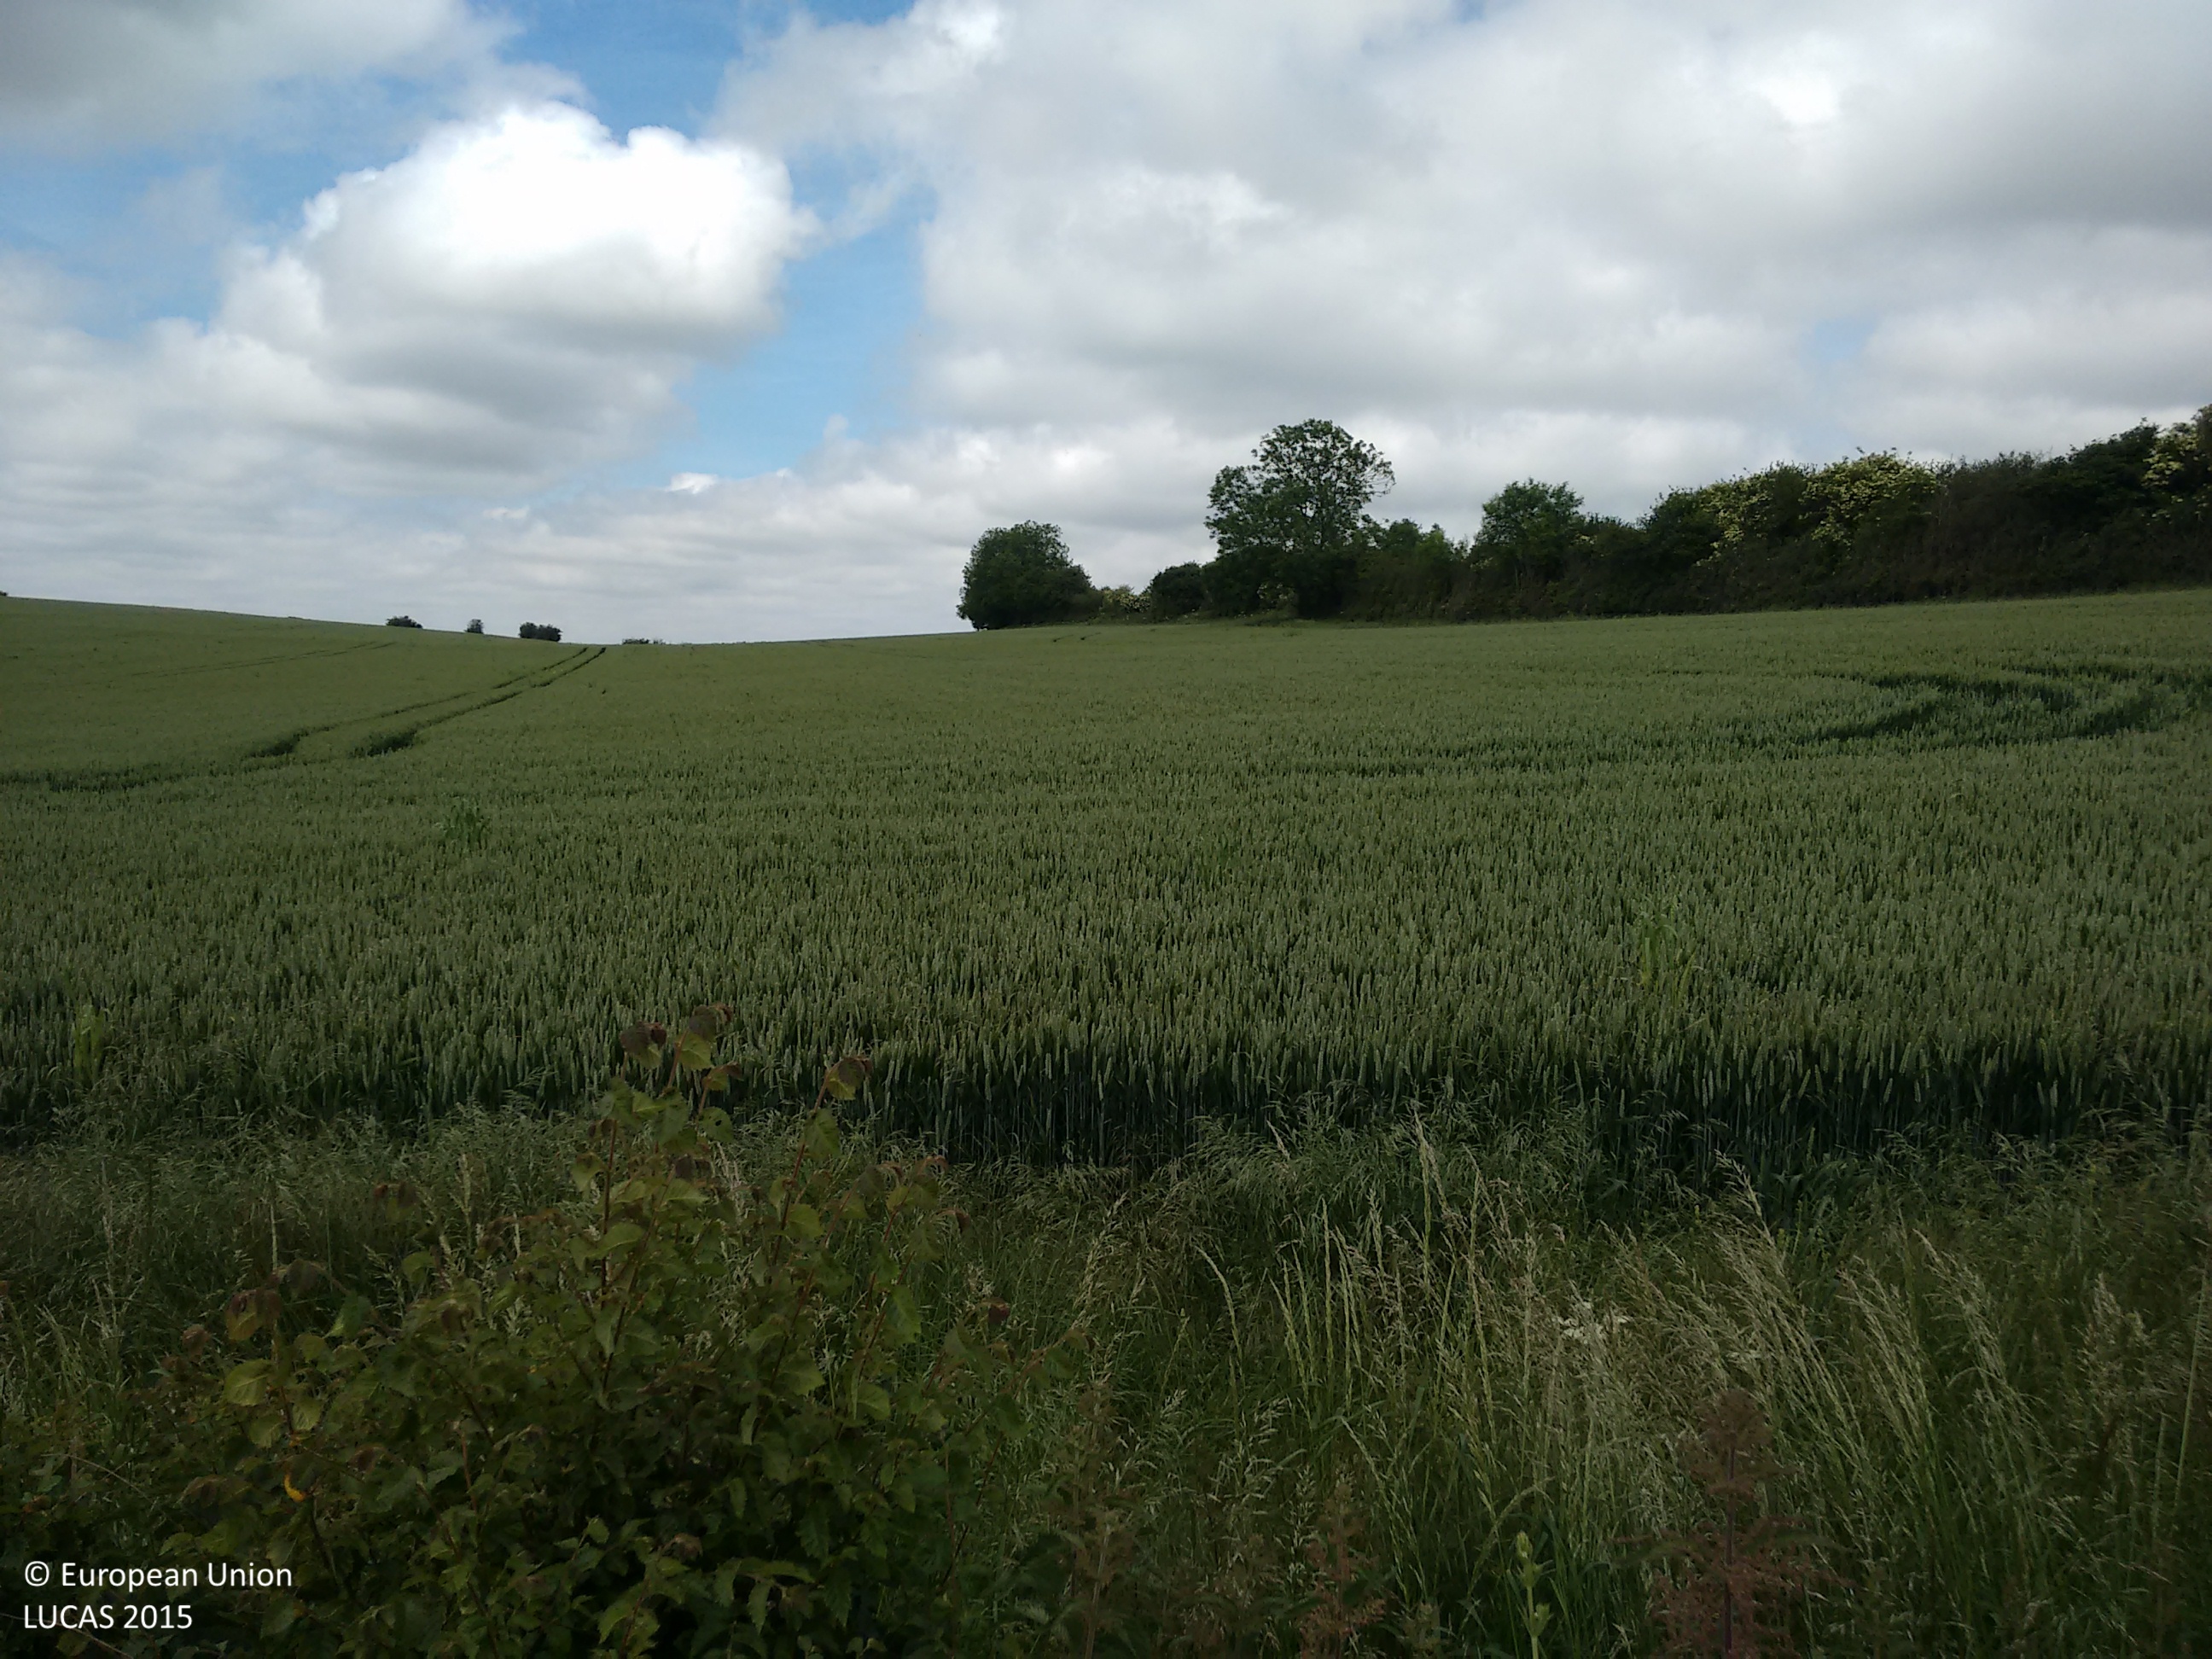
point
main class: Cropland
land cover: Common wheat
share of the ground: > 75 %
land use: Agriculture (excluding fallow land and kitchen gardens)
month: June
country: GB
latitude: 51.0413
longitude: -2.4887
